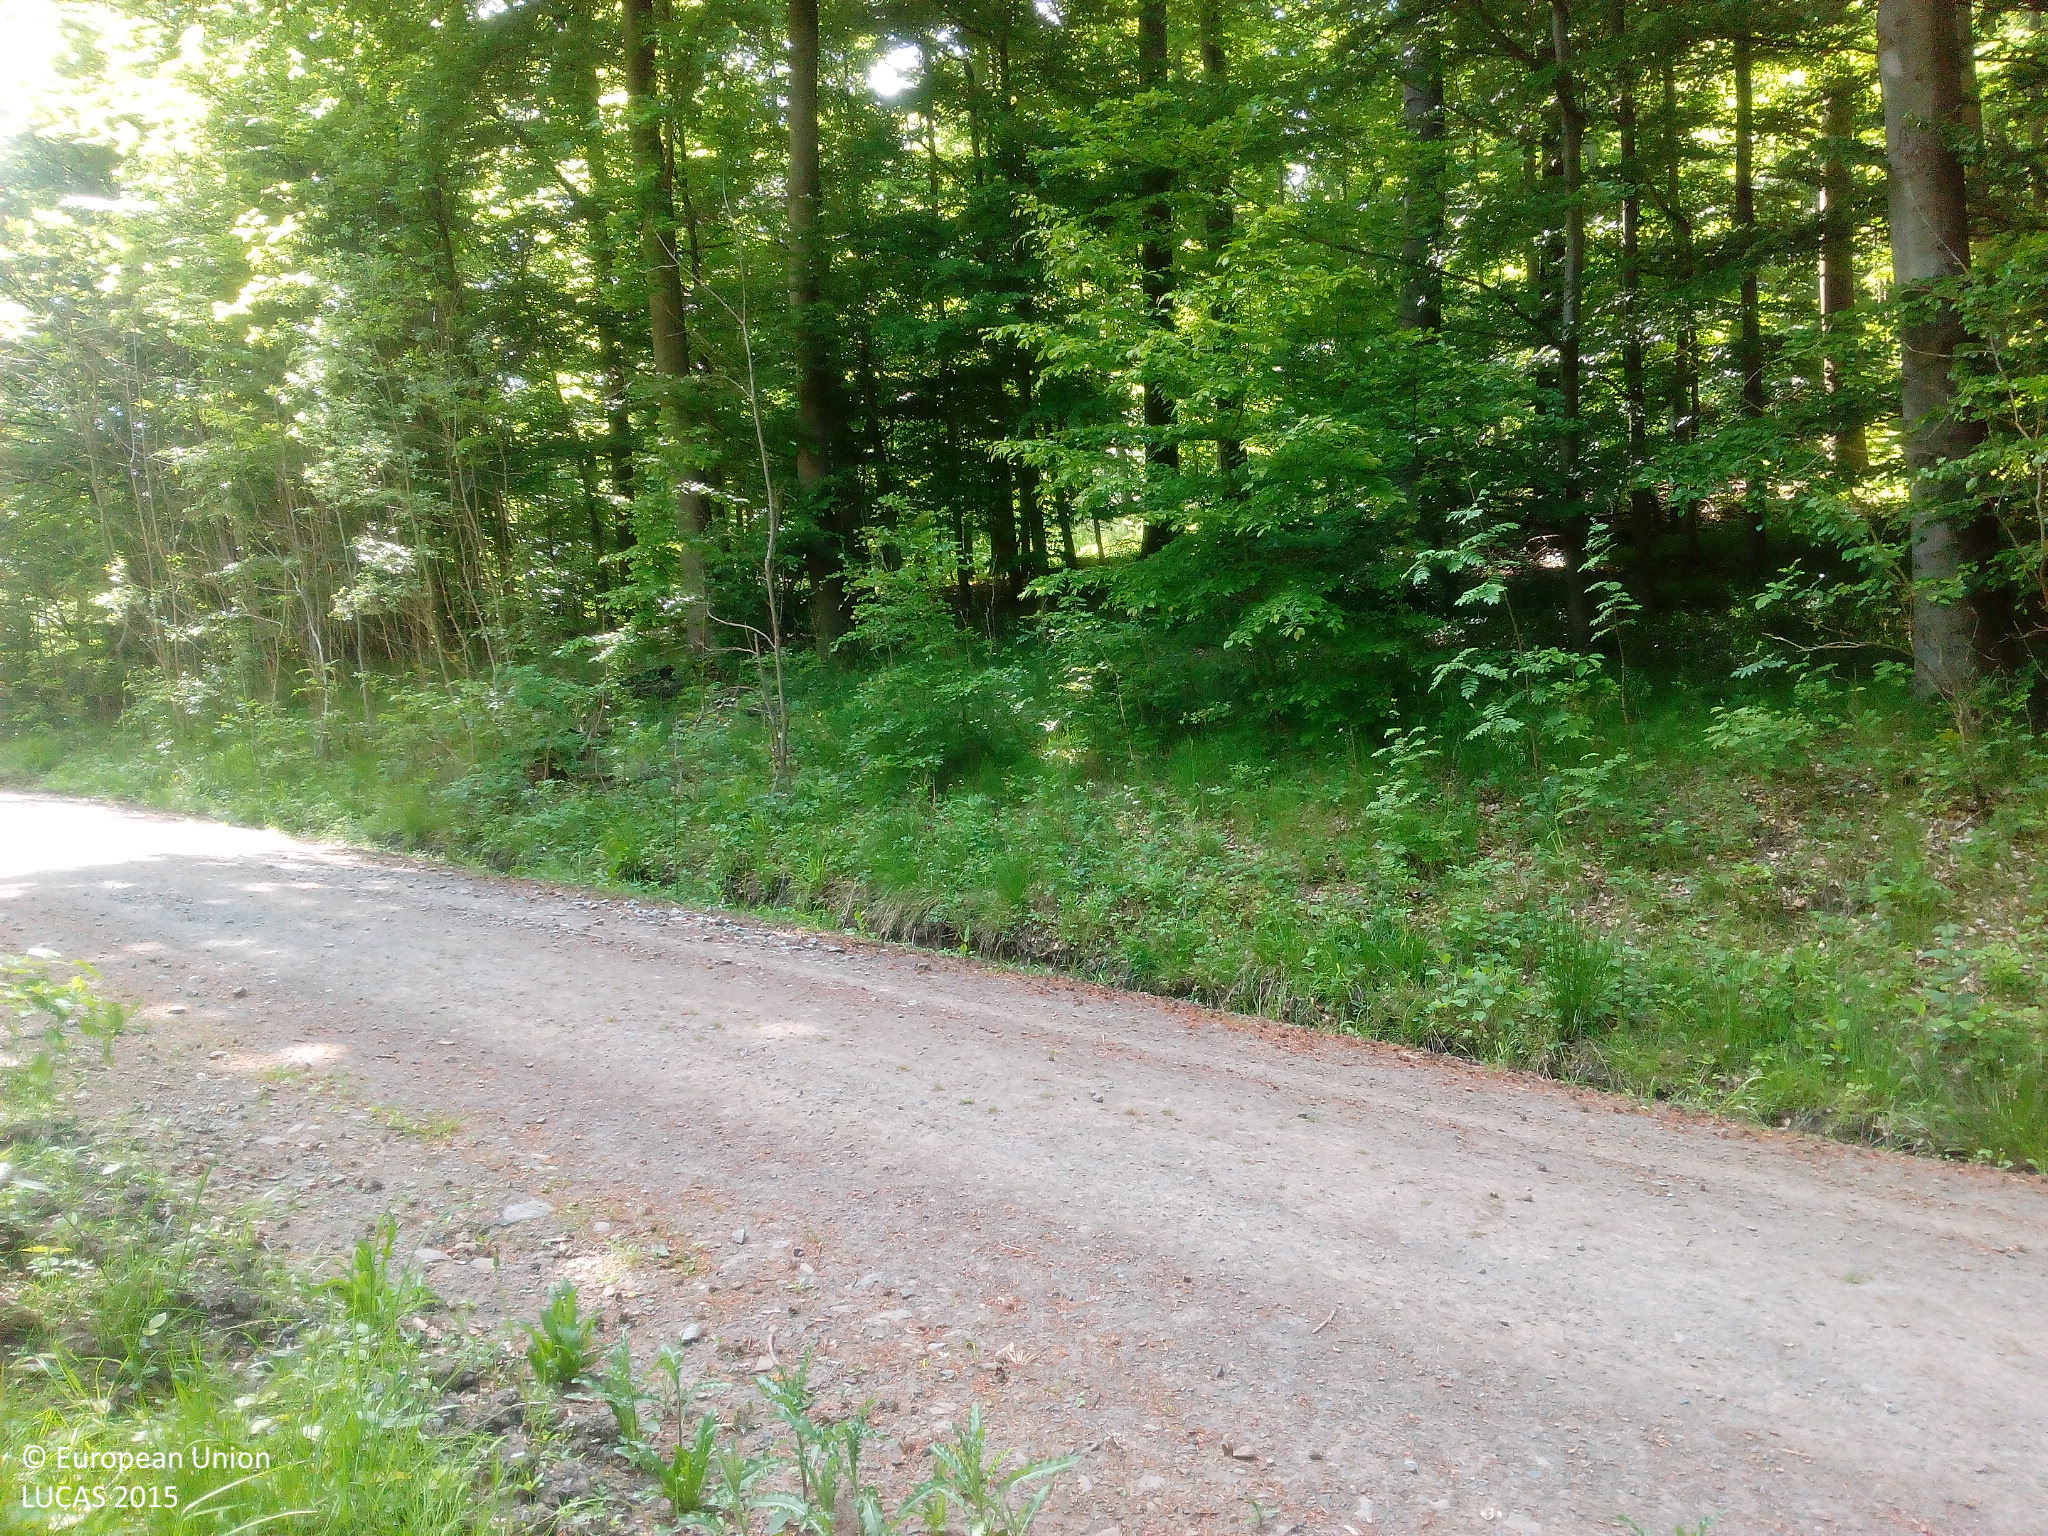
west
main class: Woodland
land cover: Broadleaved woodland
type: beech forest
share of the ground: > 75 %
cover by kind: broadleaved forest trees 100 %
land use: Forestry
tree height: > 5 m
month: May
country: DE
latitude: 51.3511
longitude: 9.3541
